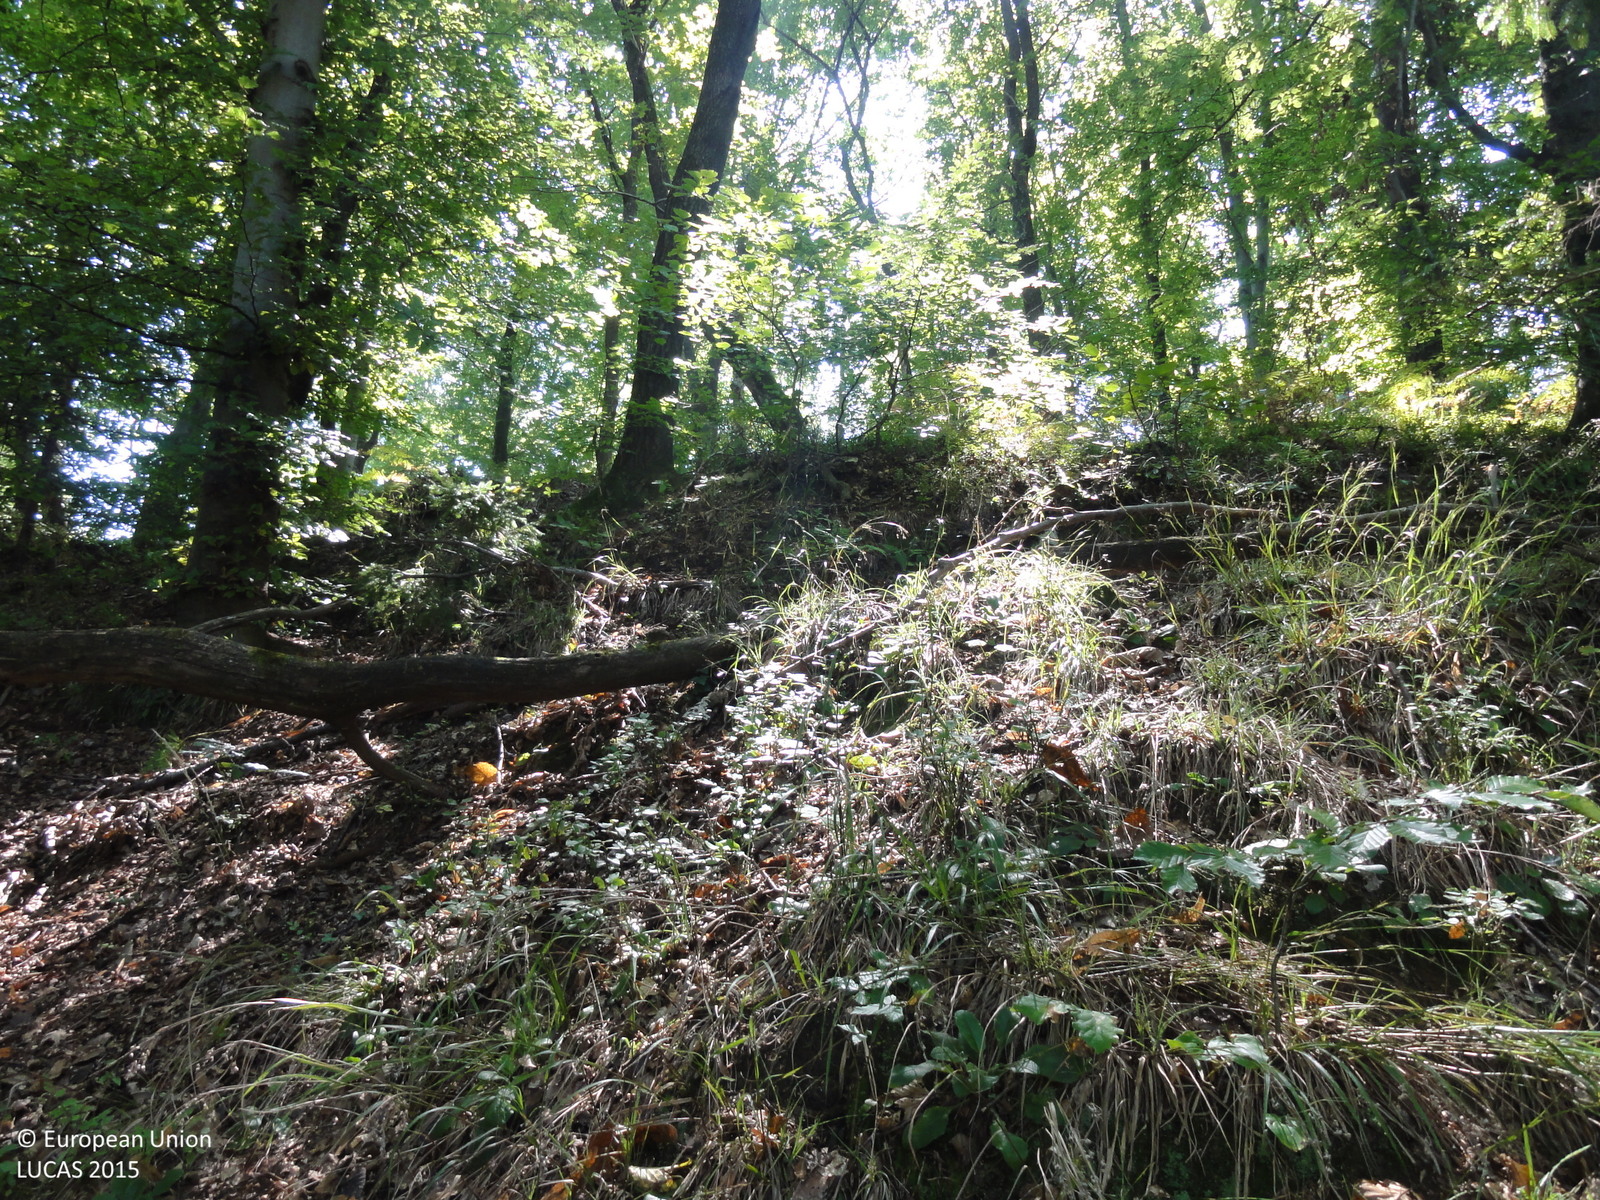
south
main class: Woodland
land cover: Broadleaved woodland
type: beech forest
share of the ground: > 75 %
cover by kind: broadleaved forest trees 95 %, coniferous forest trees 5 %
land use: Forestry
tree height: > 5 m
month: August
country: SI
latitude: 46.0118
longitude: 15.4864
